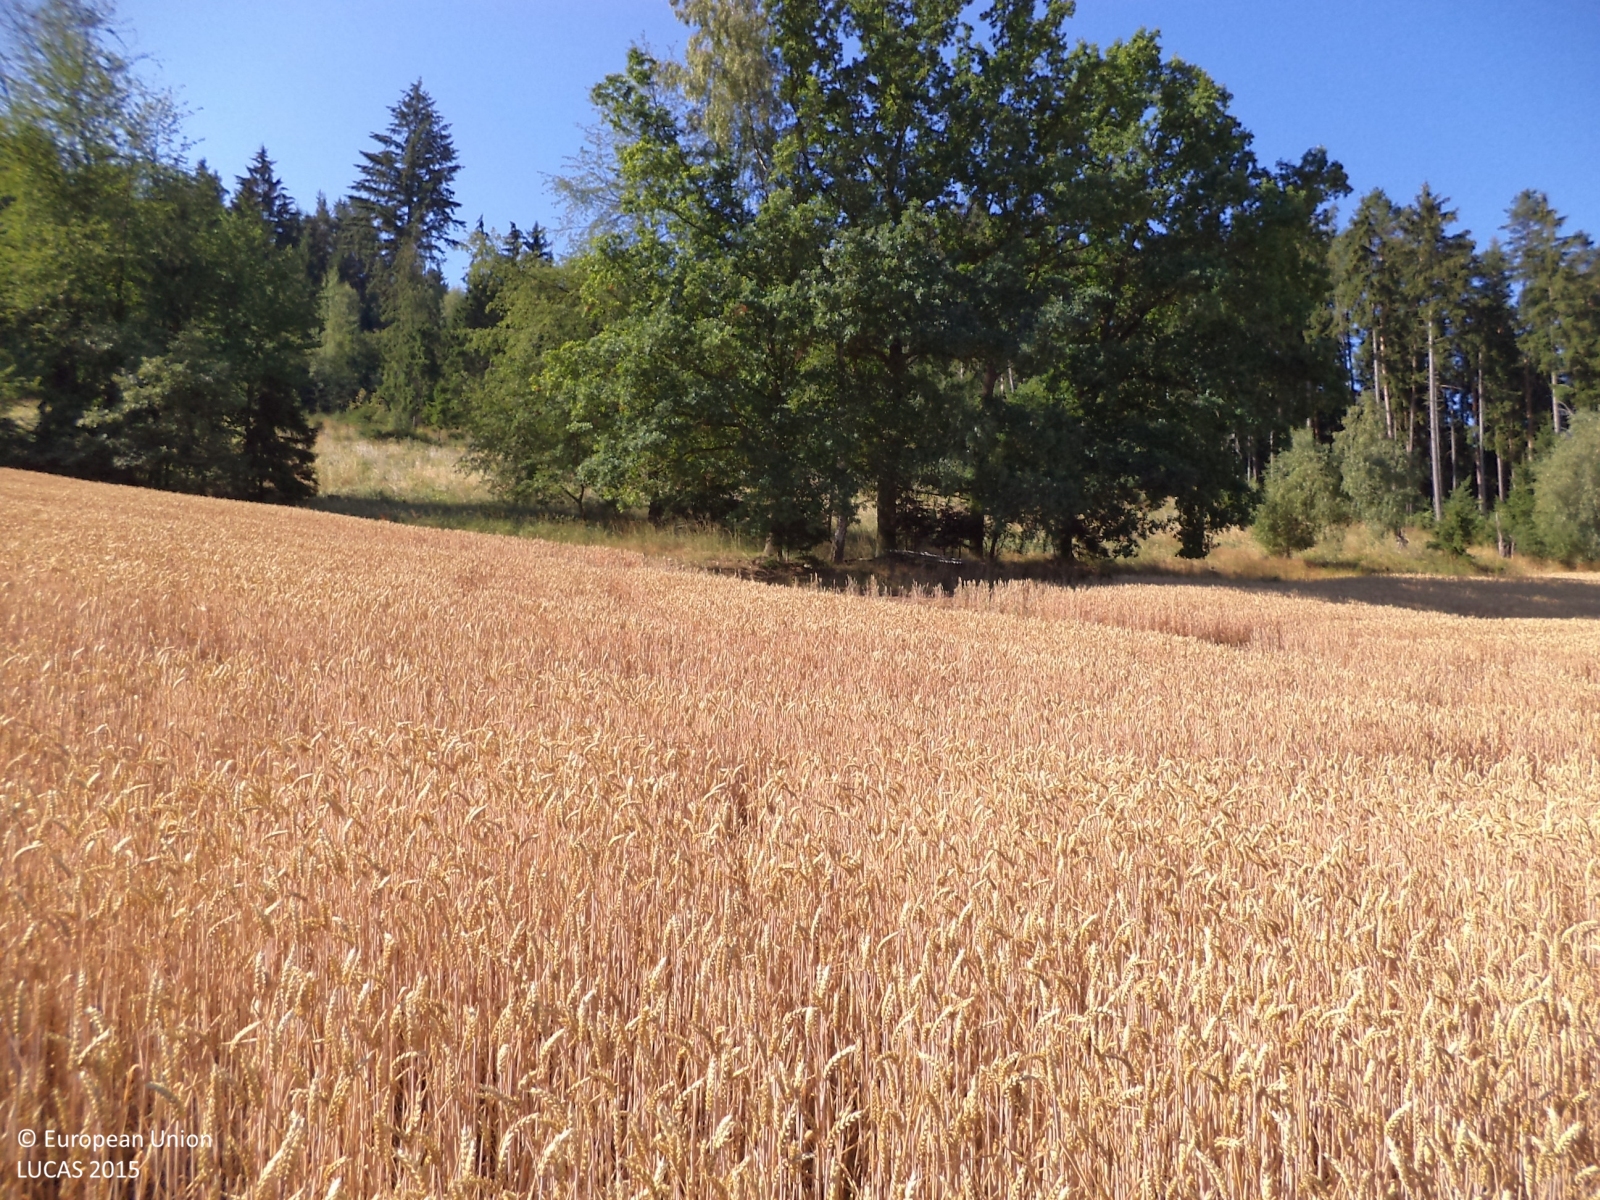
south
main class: Cropland
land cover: Common wheat
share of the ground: > 75 %
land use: Agriculture (excluding fallow land and kitchen gardens)
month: July
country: CZ
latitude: 49.7011
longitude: 14.4522
